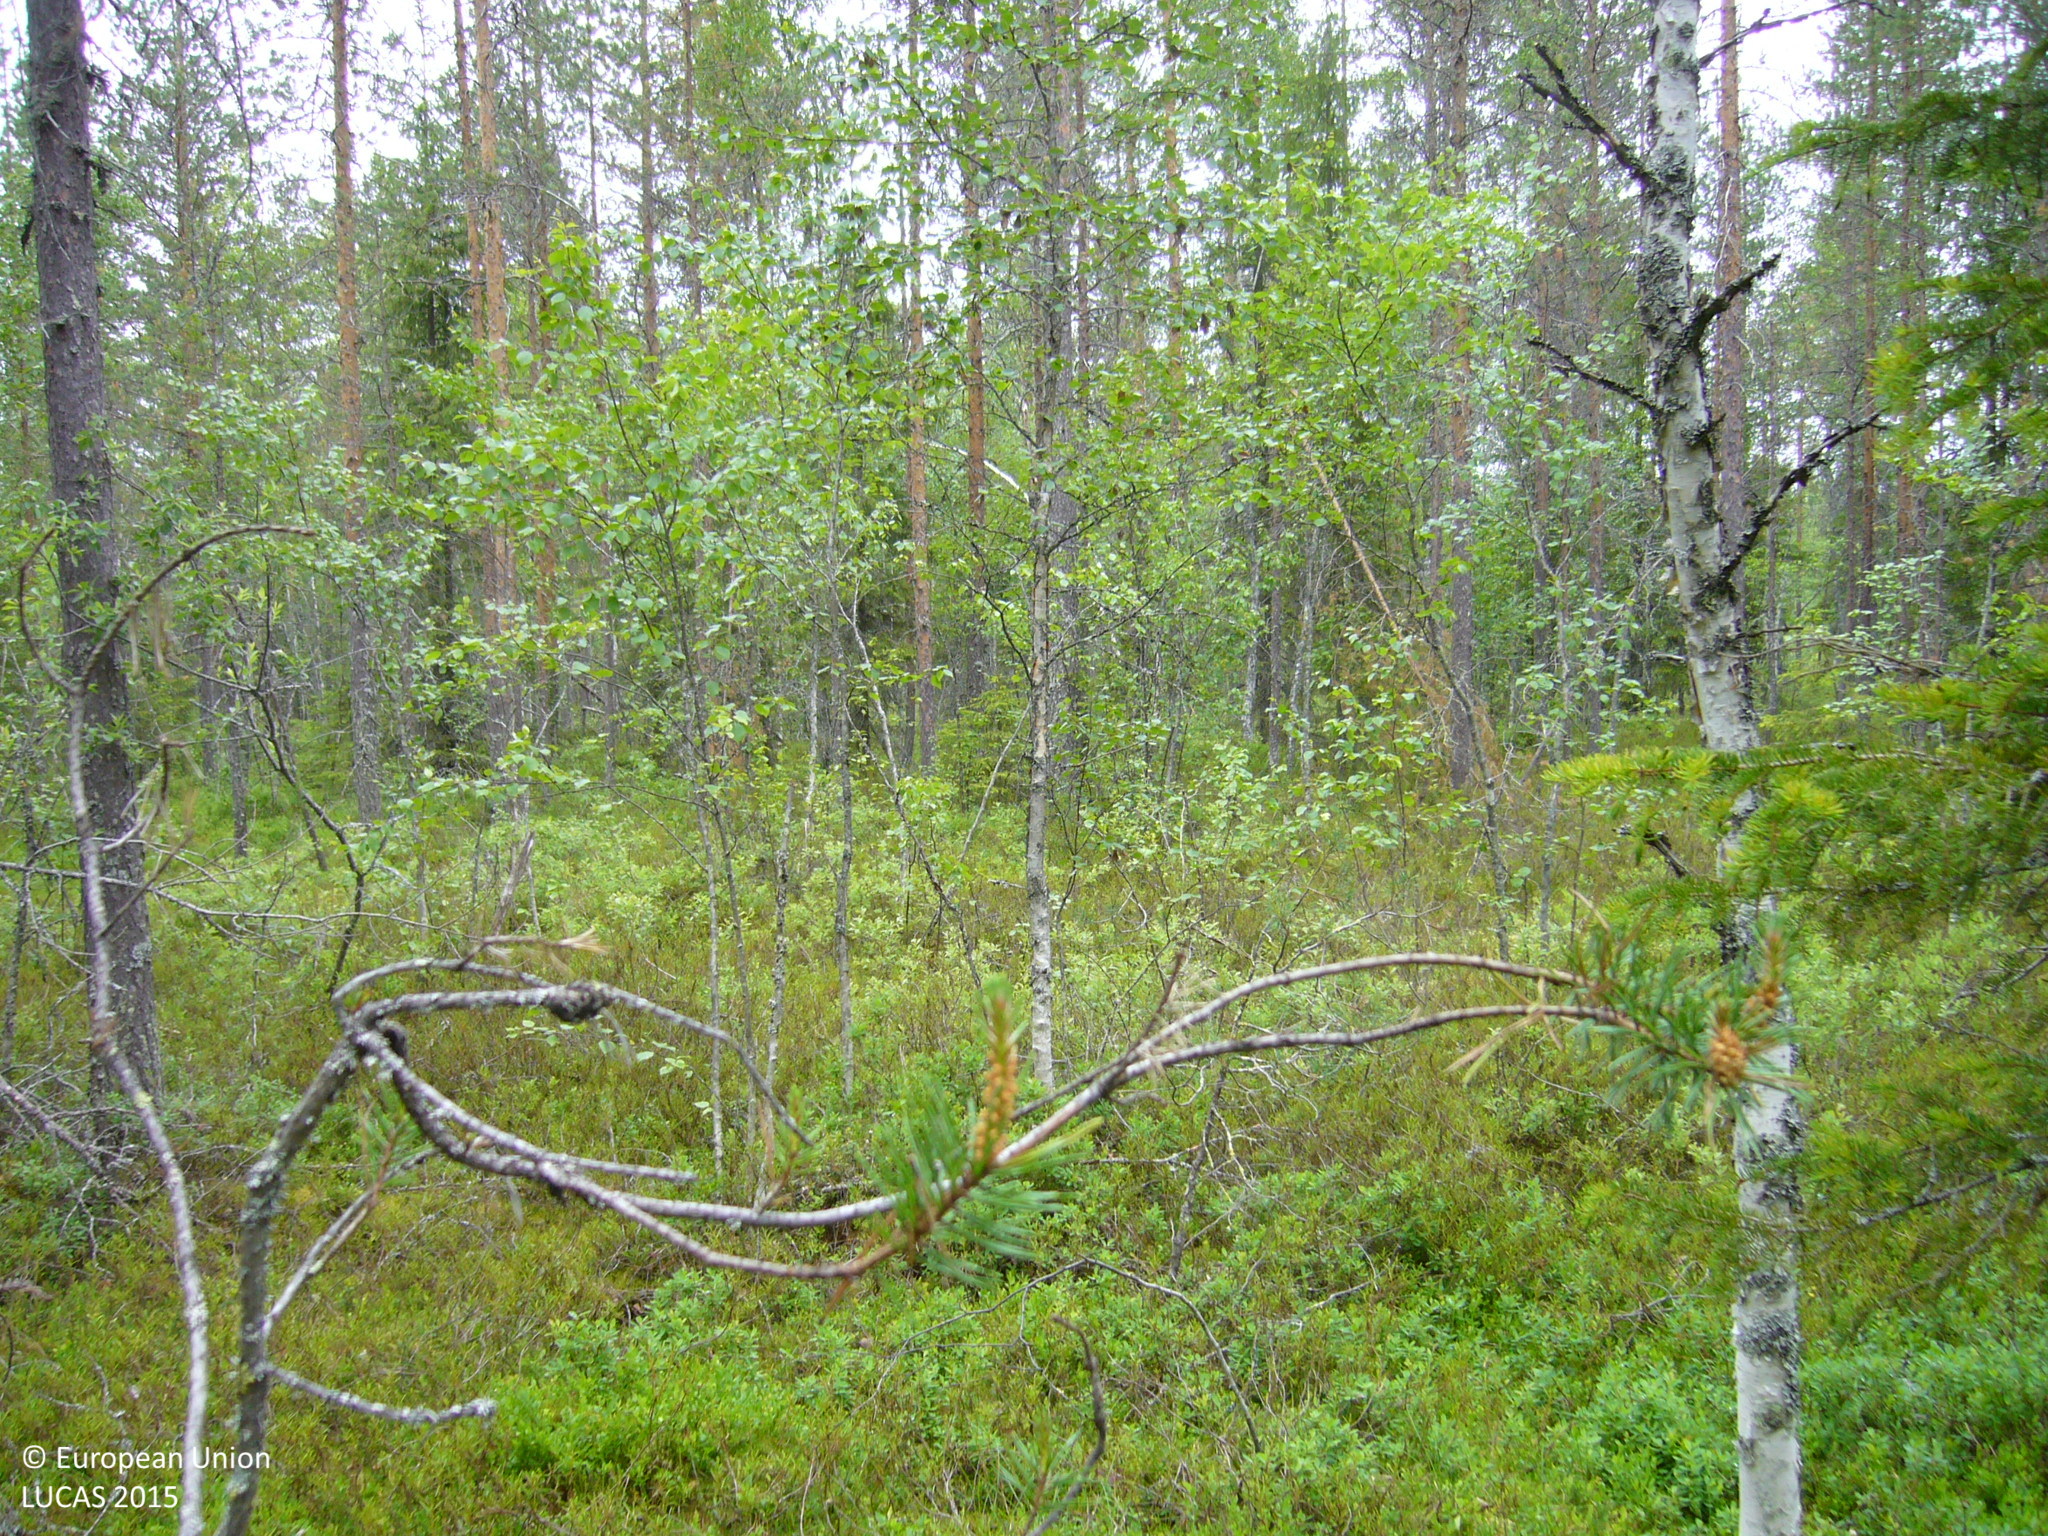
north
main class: Woodland
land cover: Pine dominated mixed woodland
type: boreal forest
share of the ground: 50 - 75 %
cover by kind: coniferous forest trees 40 %, shrubs 35 %, broadleaved forest trees 25 %
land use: Forestry
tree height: > 5 m
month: July
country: FI
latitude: 63.4338
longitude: 25.9662
